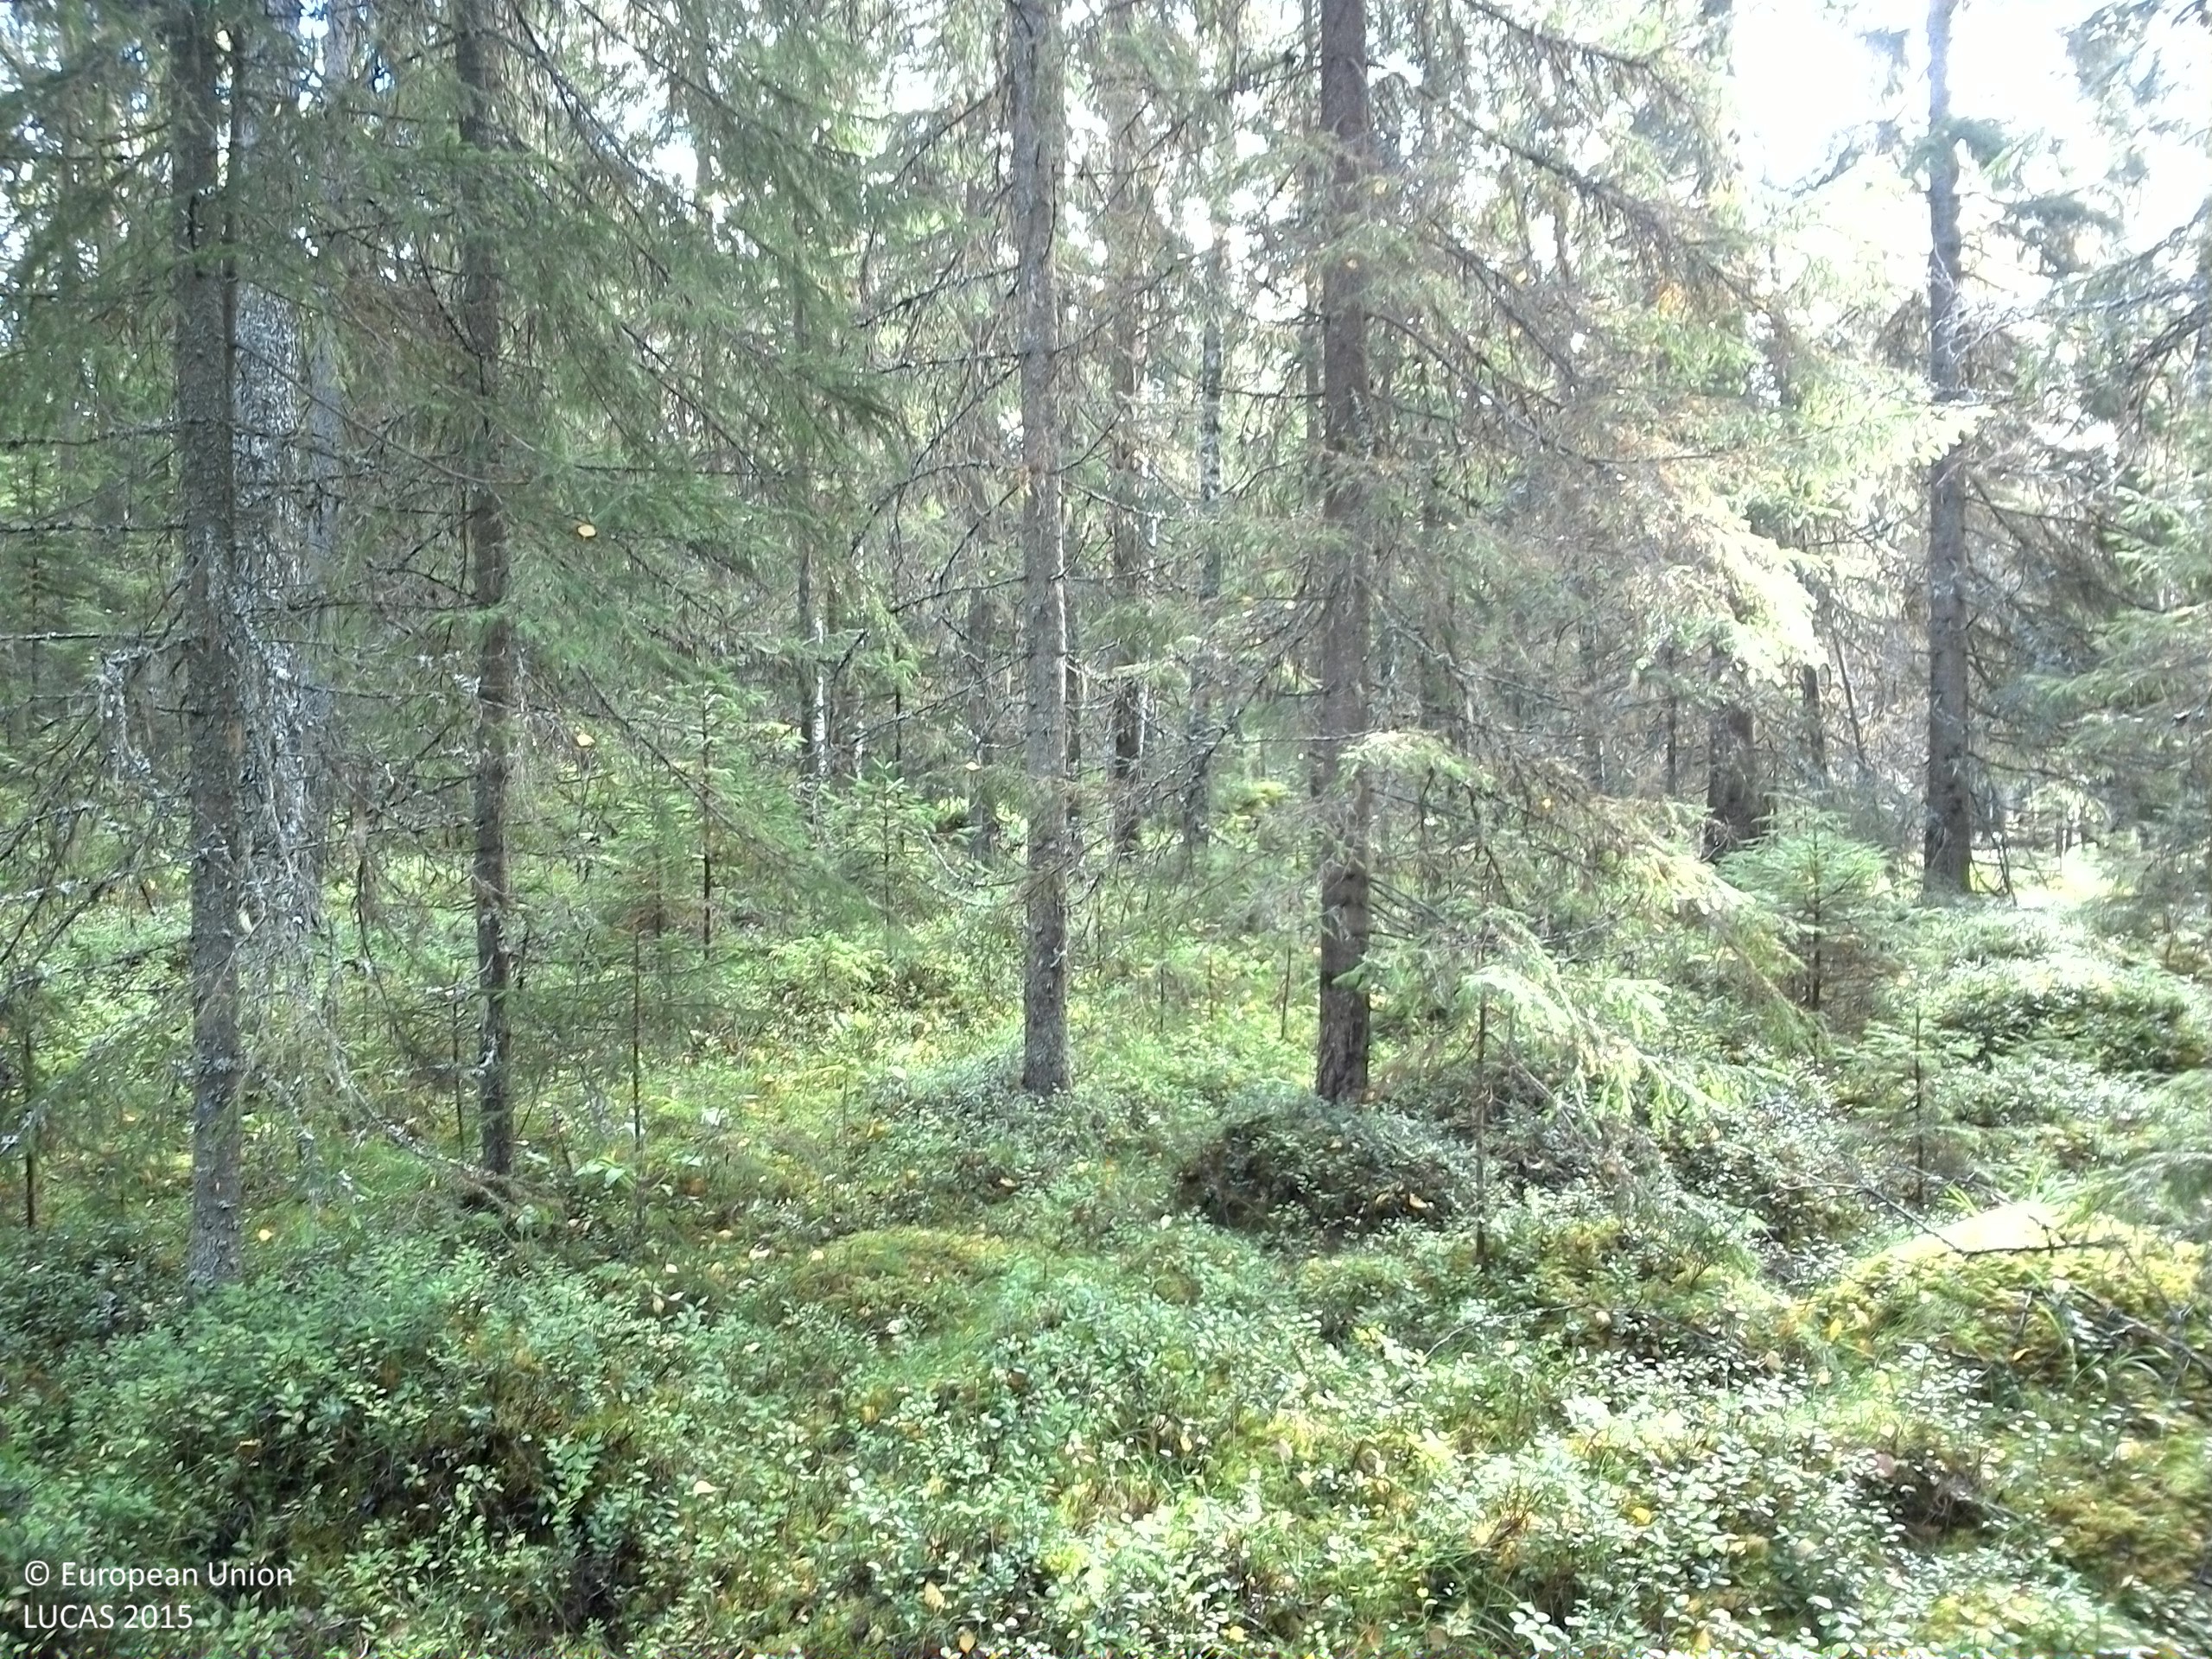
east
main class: Woodland
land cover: Spruce dominated mixed woodland
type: boreal forest
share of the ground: 50 - 75 %
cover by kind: coniferous forest trees 45 %, shrubs 25 %, broadleaved forest trees 15 %, lichens and mosses 15 %
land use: Forestry
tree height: > 5 m
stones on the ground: 10 - 25 %
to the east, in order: Spruce dominated mixed woodland; Spruce dominated coniferous woodland; Other coniferous woodland; Pine dominated coniferous woodland
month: September
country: SE
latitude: 61.3443
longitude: 15.3123
